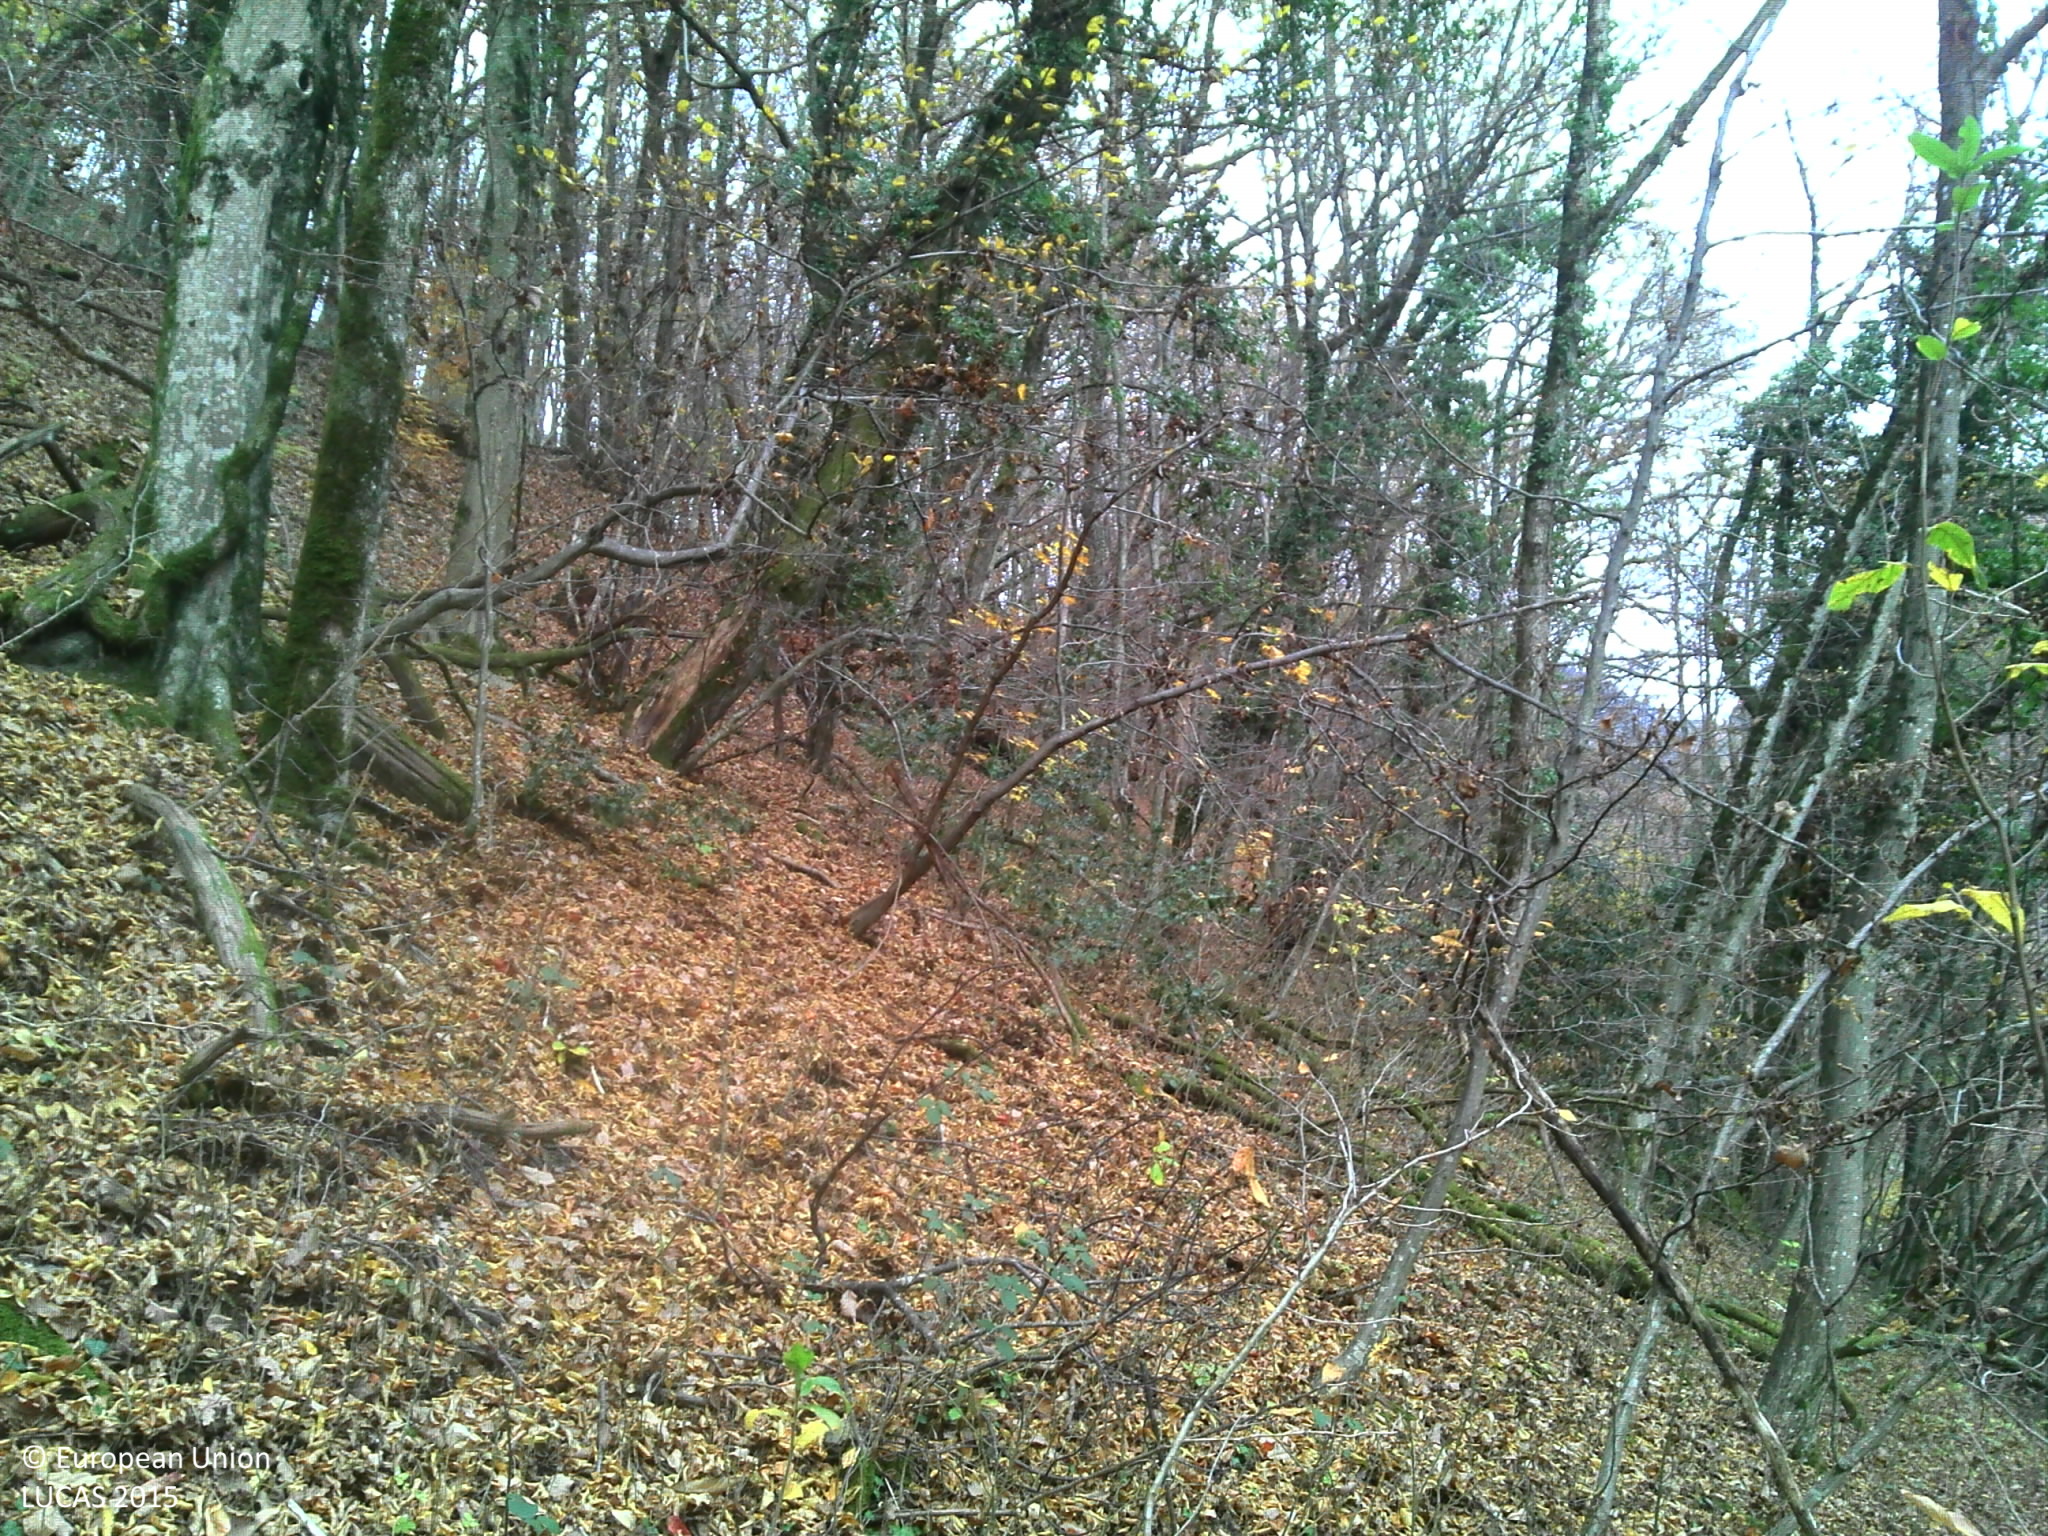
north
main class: Woodland
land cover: Broadleaved woodland
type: mesophytic deciduous forest
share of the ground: > 75 %
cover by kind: broadleaved forest trees 90 %, shrubs 5 %, unconsolidated bare surface 5 %
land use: Forestry
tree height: > 5 m
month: November
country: FR
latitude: 45.6963
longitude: 6.4213
